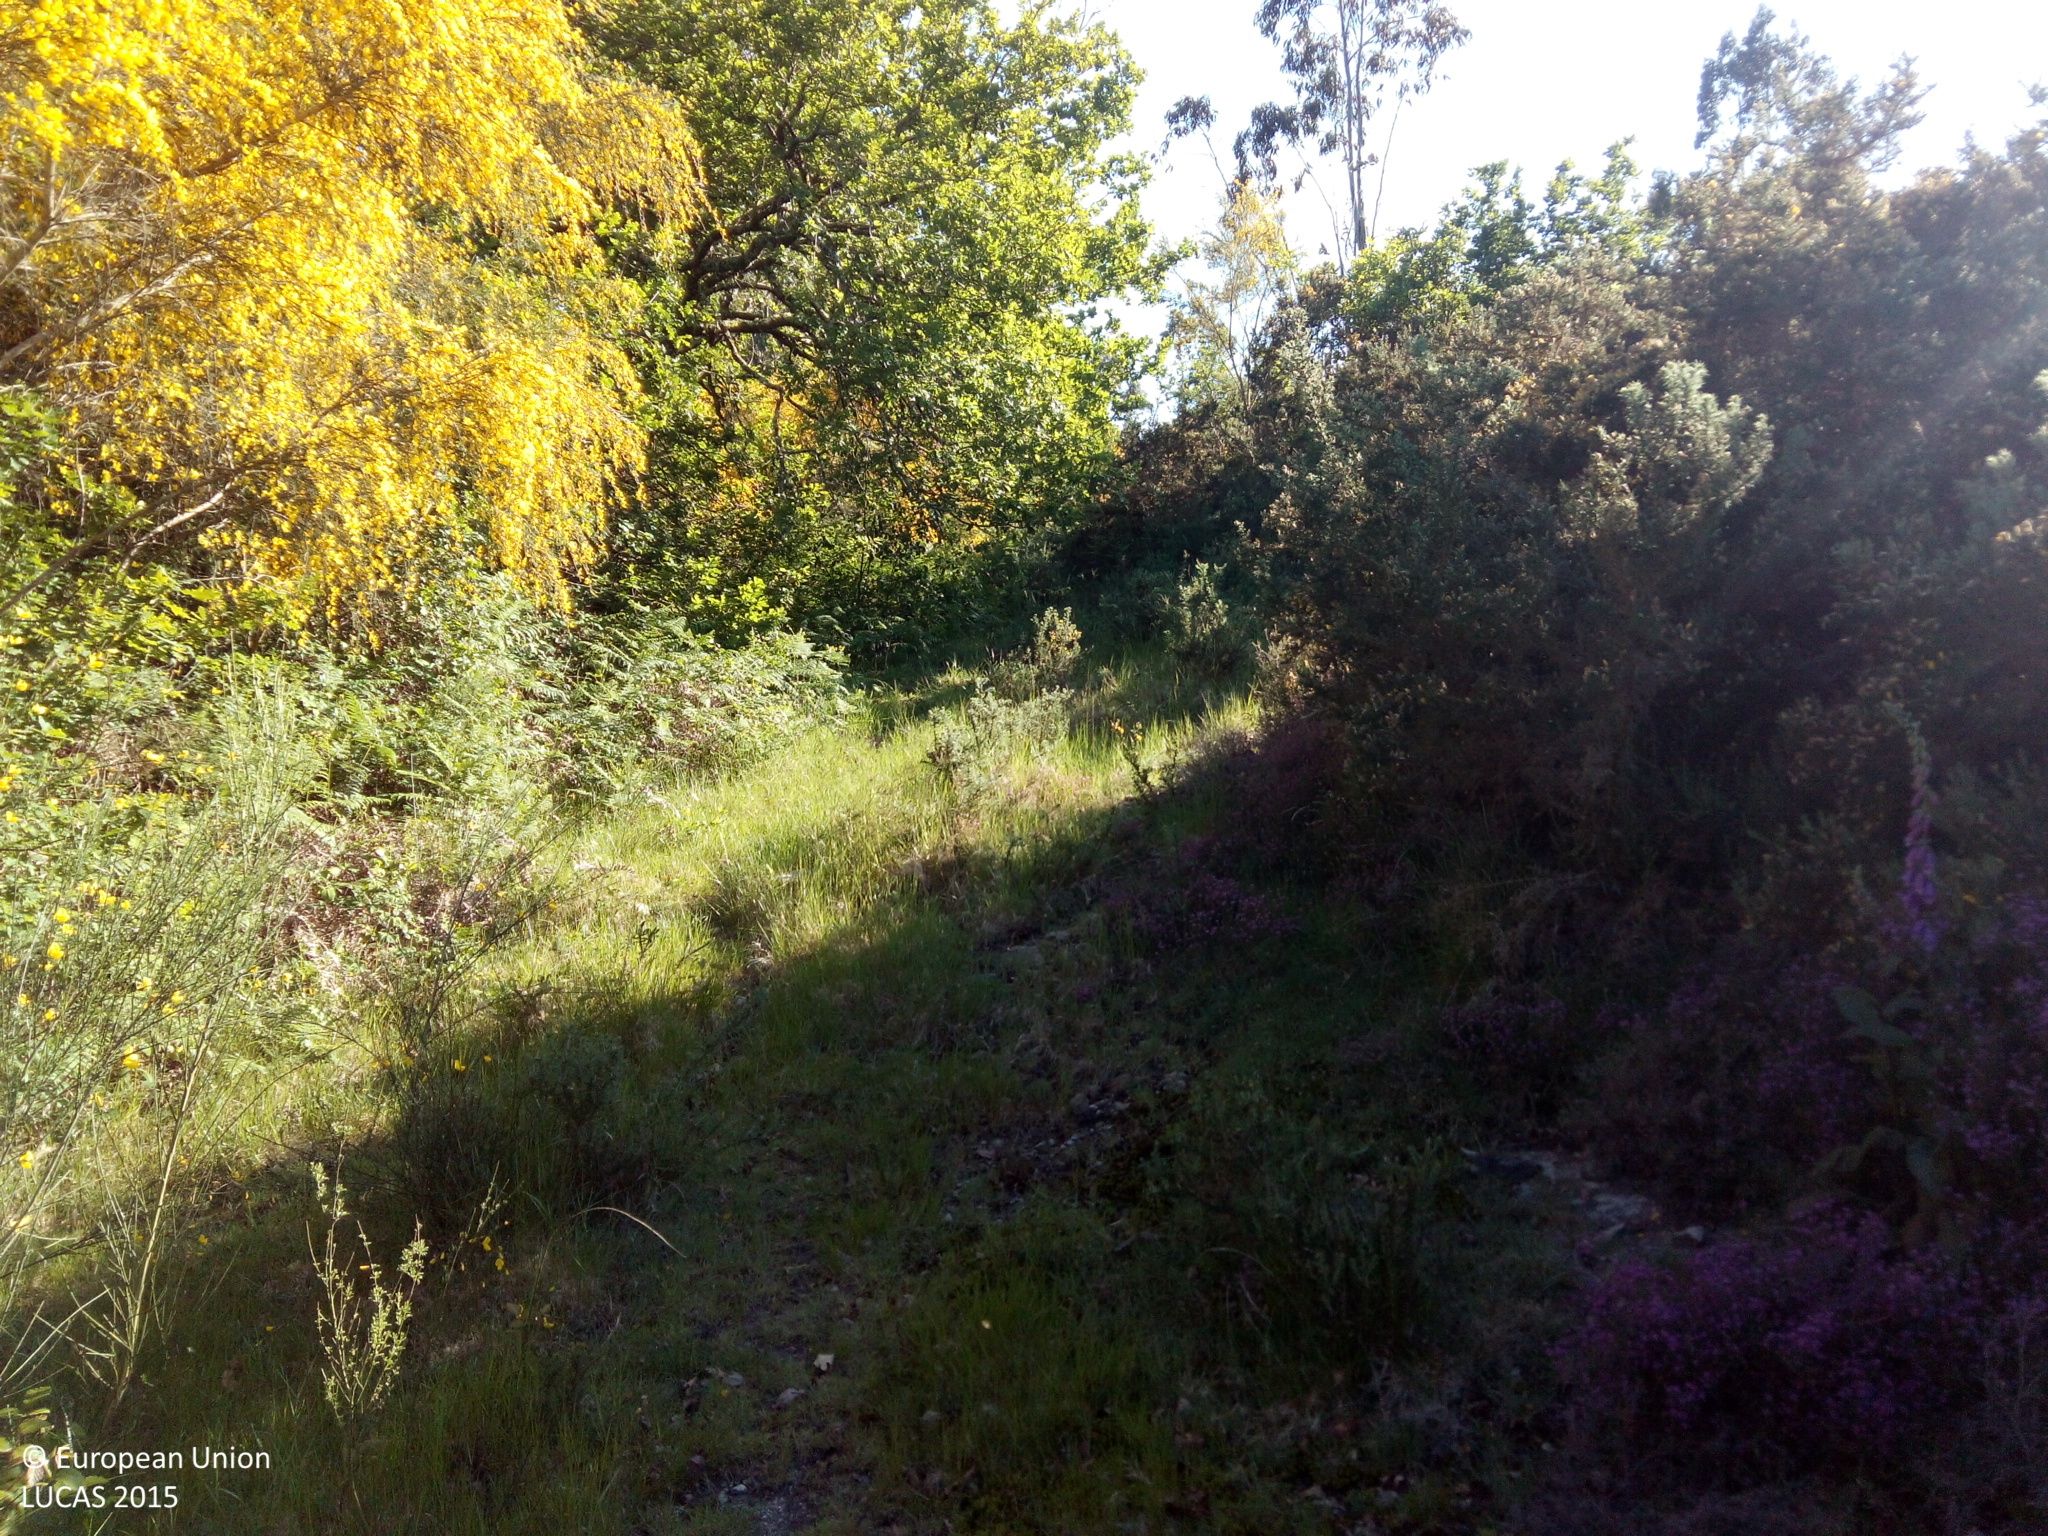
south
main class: Woodland
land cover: Broadleaved woodland
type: acidophilous oak and oak-birch forest
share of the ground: > 75 %
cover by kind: broadleaved forest trees 100 %
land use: Forestry
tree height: > 5 m
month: May
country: ES
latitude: 42.5360
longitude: -8.4204
